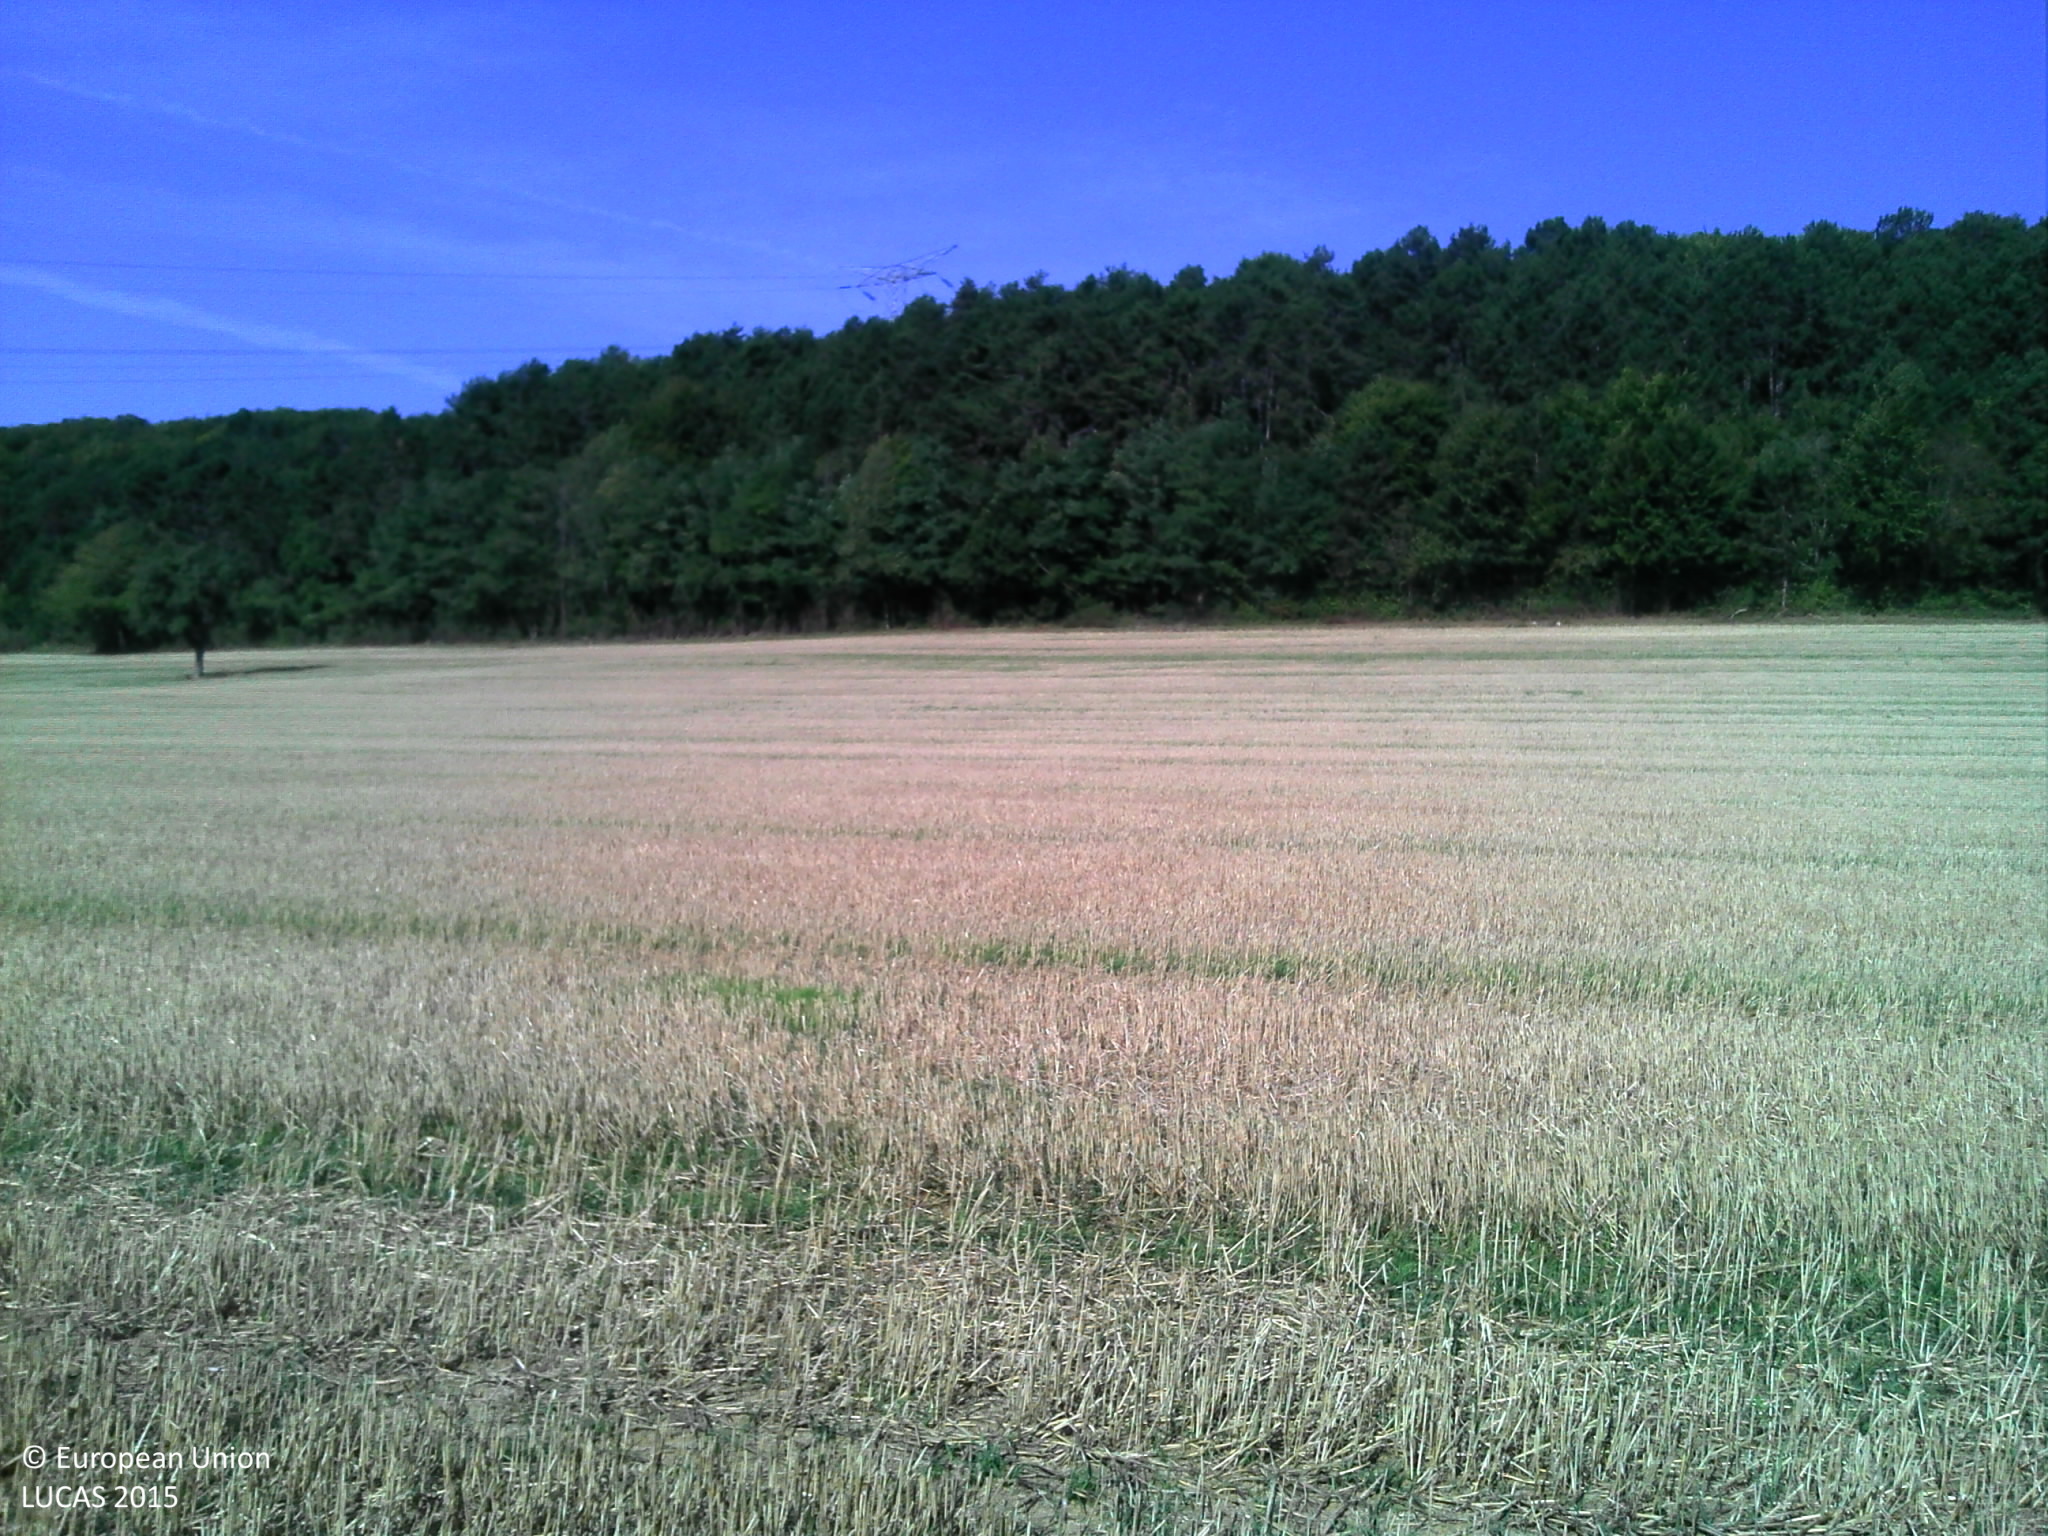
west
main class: Cropland
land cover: Common wheat
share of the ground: > 75 %
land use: Agriculture (excluding fallow land and kitchen gardens)
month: August
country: FR
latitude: 47.2202
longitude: 4.8635
